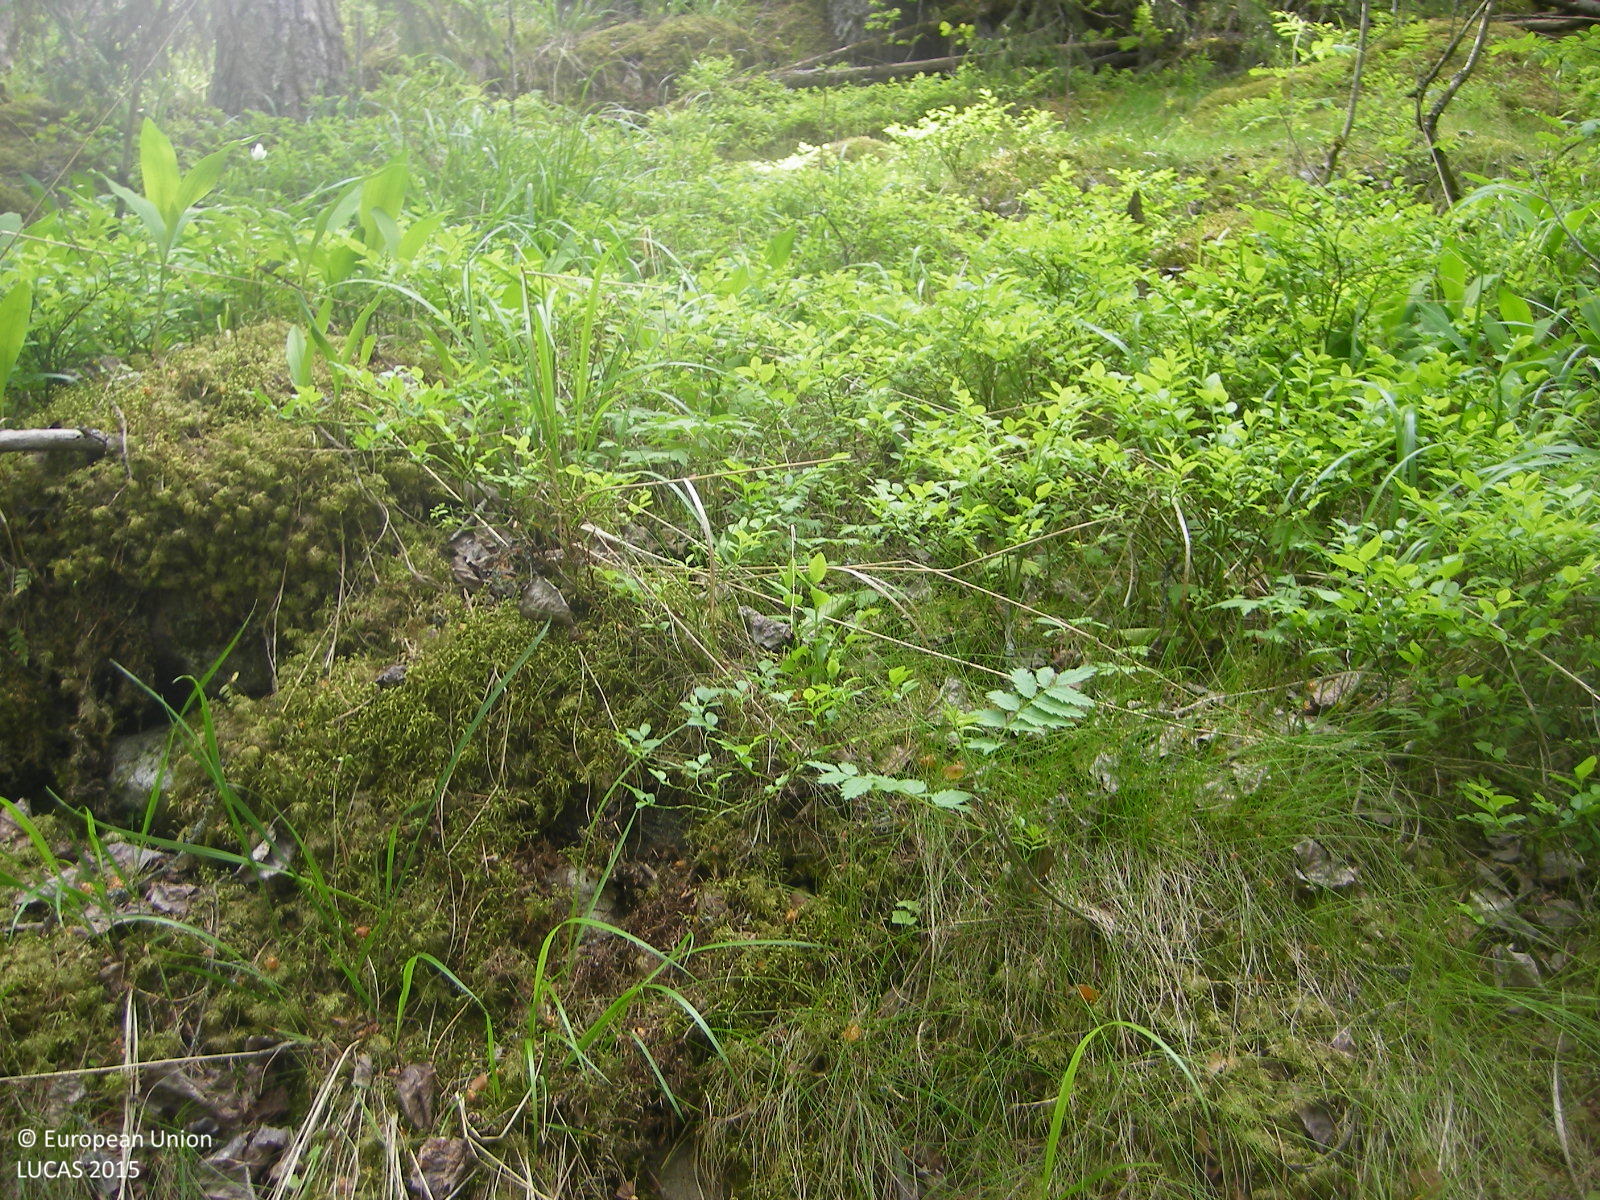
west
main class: Woodland
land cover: Spruce dominated mixed woodland
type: boreal forest
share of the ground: 50 - 75 %
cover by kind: broadleaved forest trees 40 %, coniferous forest trees 30 %, shrubs 15 %, herbaceous plants 10 %, lichens and mosses 5 %
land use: Forestry
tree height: > 5 m
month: June
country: FI
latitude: 60.3514
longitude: 24.7746
